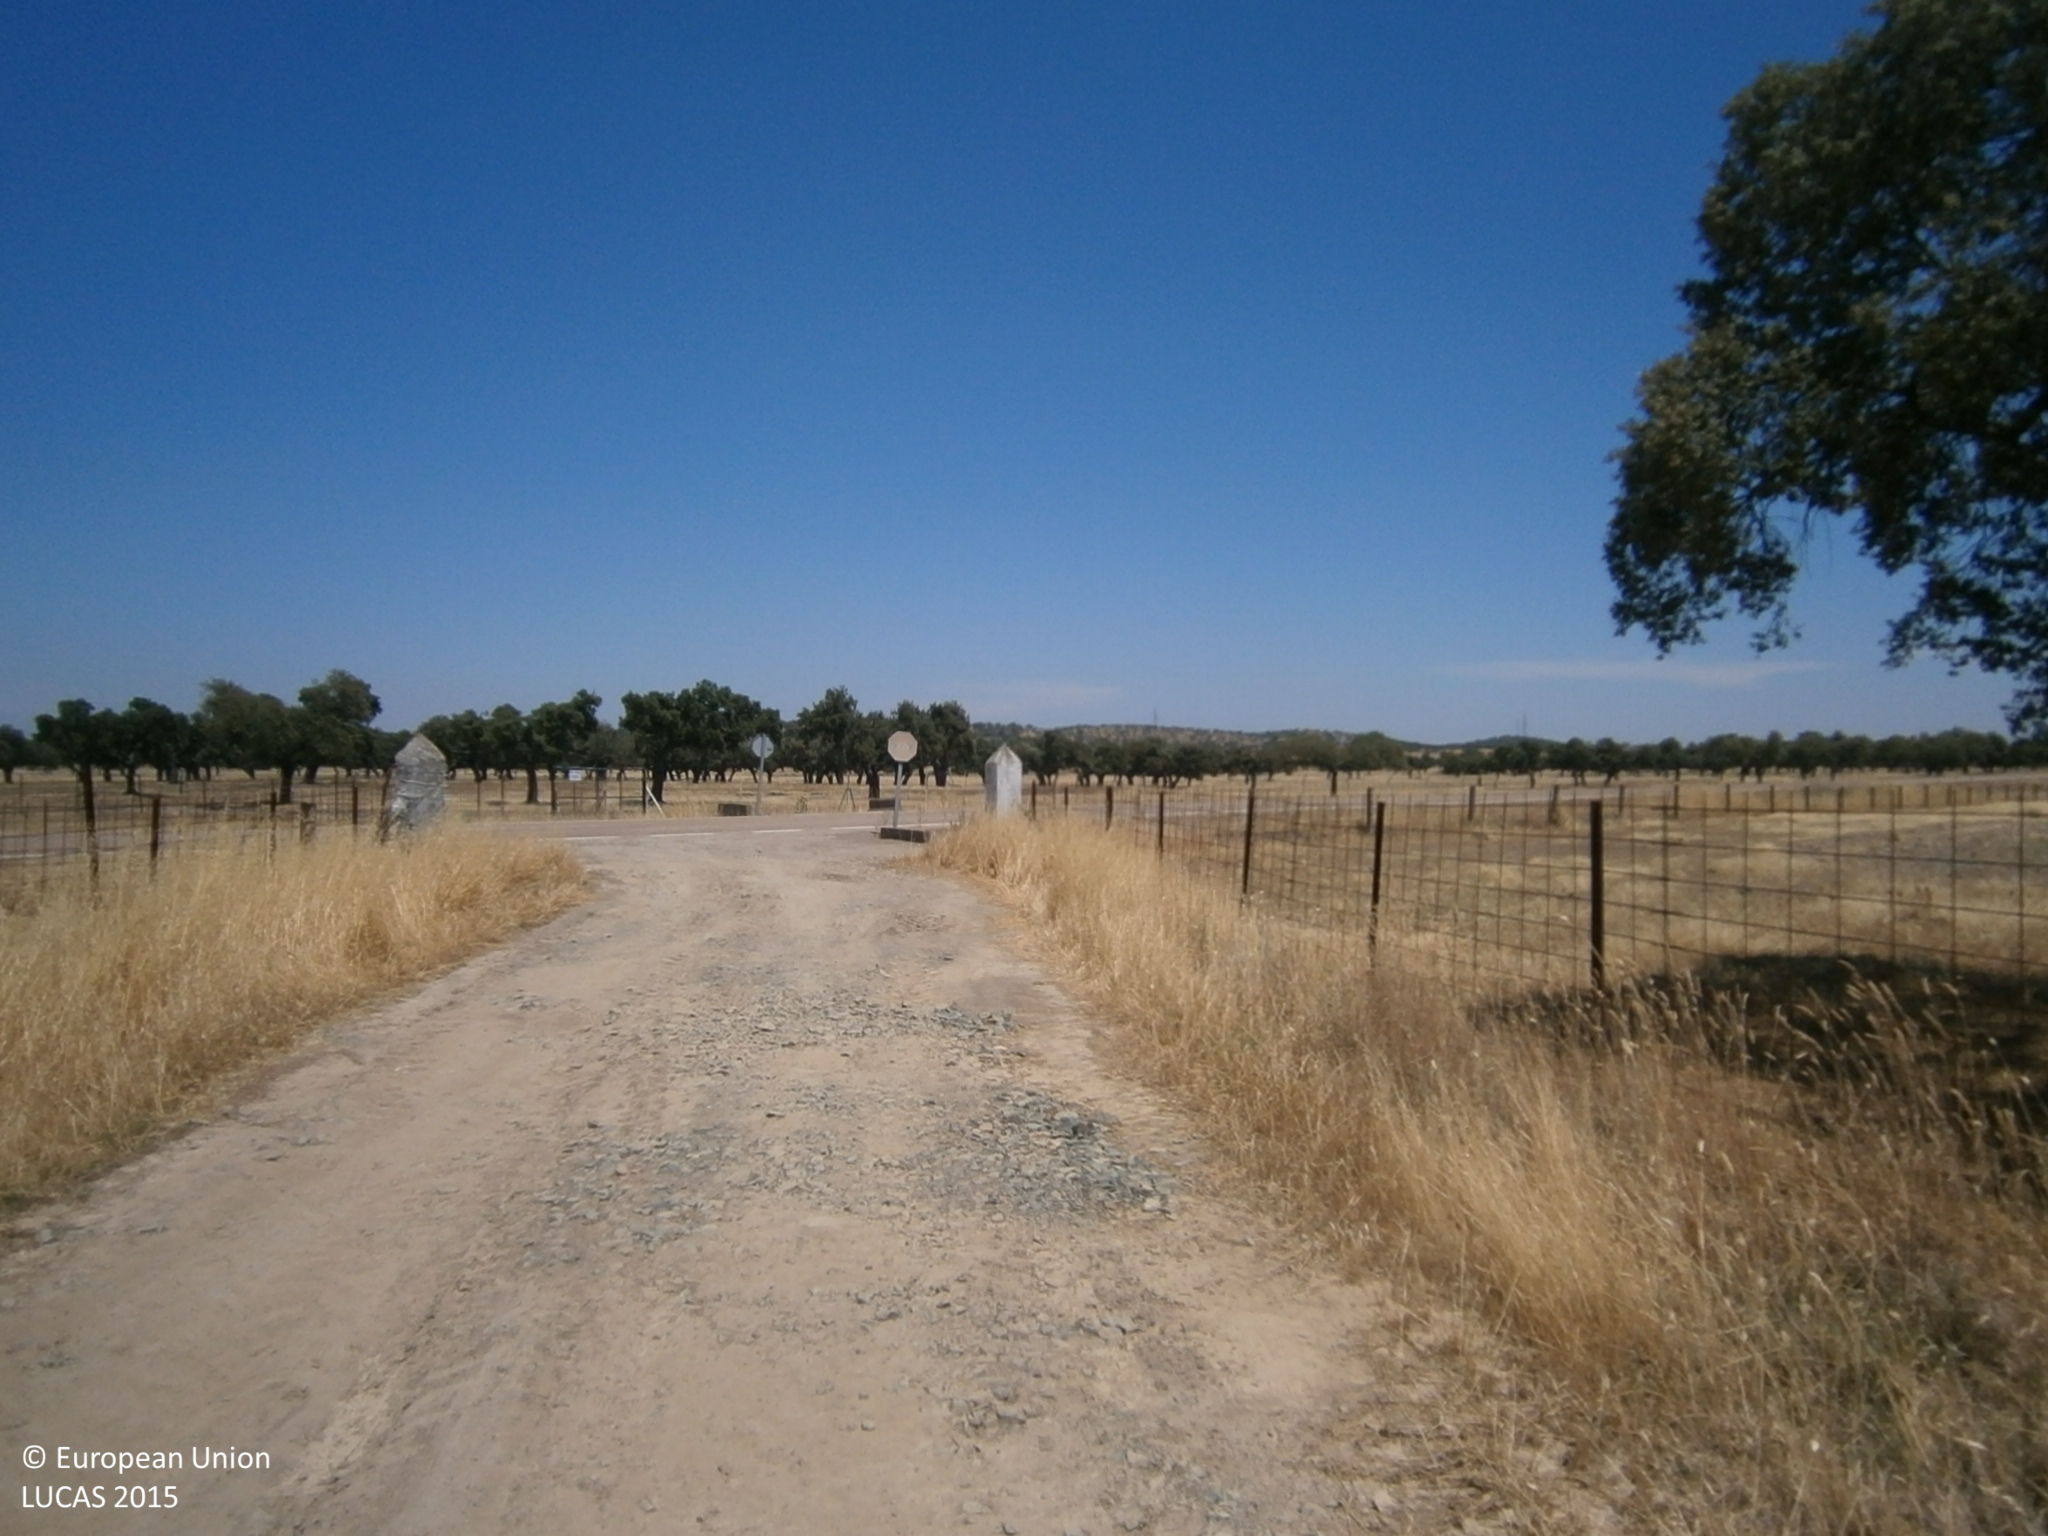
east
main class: Grassland
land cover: Grassland with sparse tree/shrub cover
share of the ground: > 75 %
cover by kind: herbaceous plants 90 %, broadleaved forest trees 5 %, shrubs 5 %
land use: Agriculture (excluding fallow land and kitchen gardens)
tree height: > 5 m
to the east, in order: Grassland with sparse tree/shrub cover
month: June
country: ES
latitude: 38.6288
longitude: -6.8684
